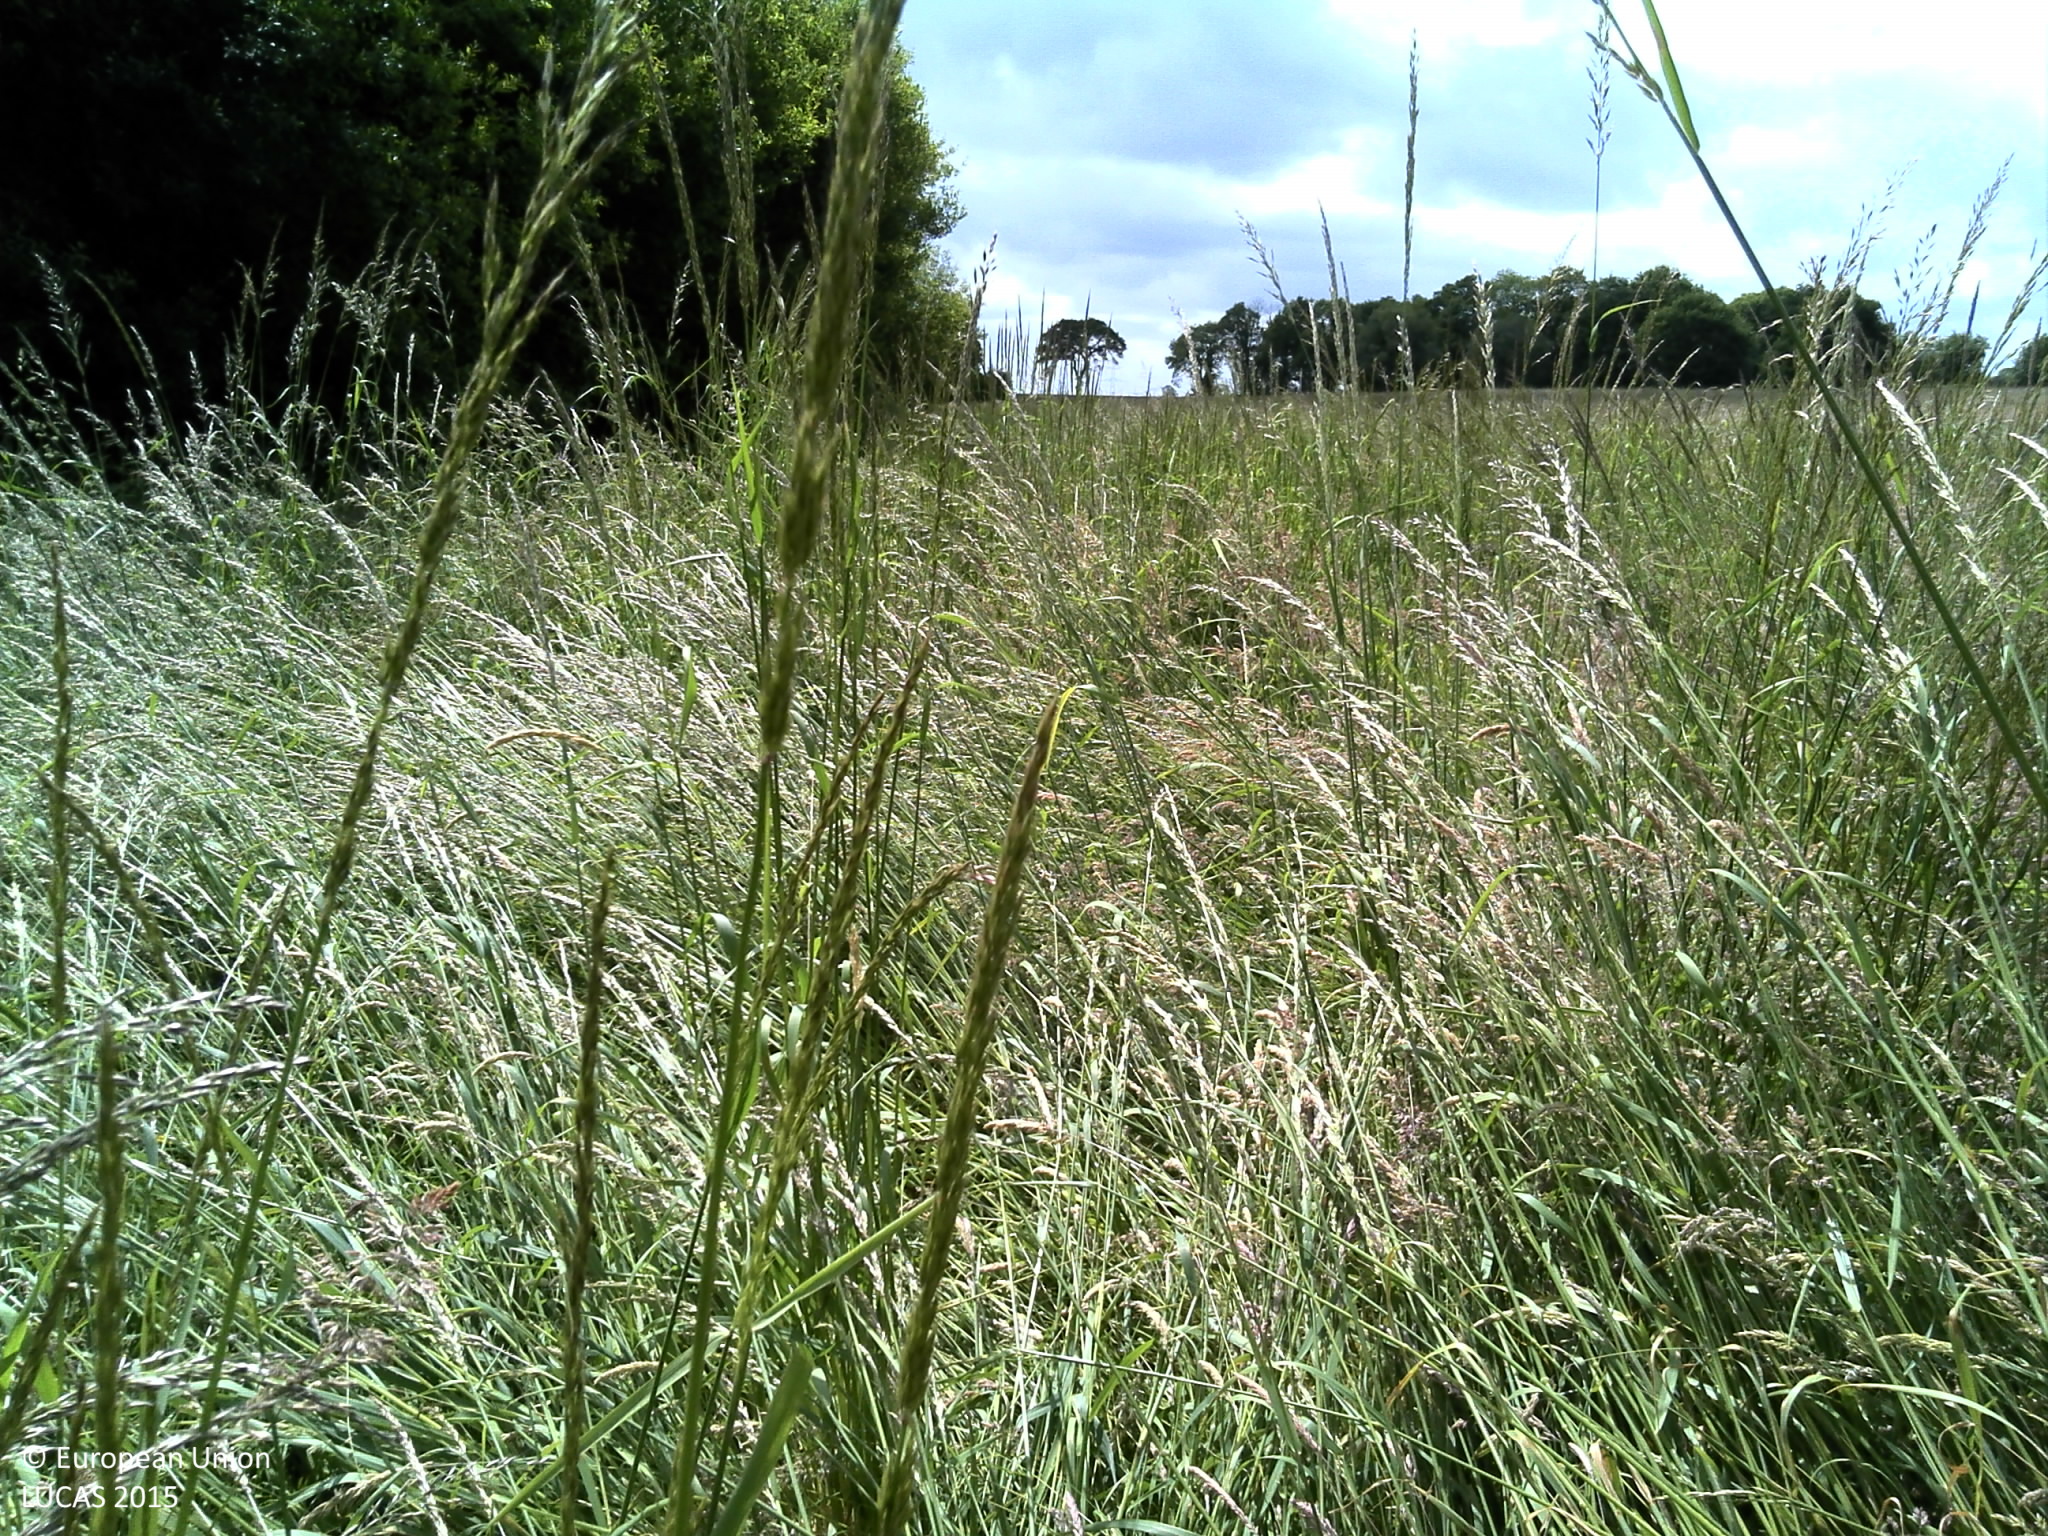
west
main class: Grassland
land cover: Grassland without tree/shrub cover
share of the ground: > 75 %
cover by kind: herbaceous plants 100 %
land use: Agriculture (excluding fallow land and kitchen gardens)
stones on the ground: < 10 %
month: June
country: FR
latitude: 47.9465
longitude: -3.5599
